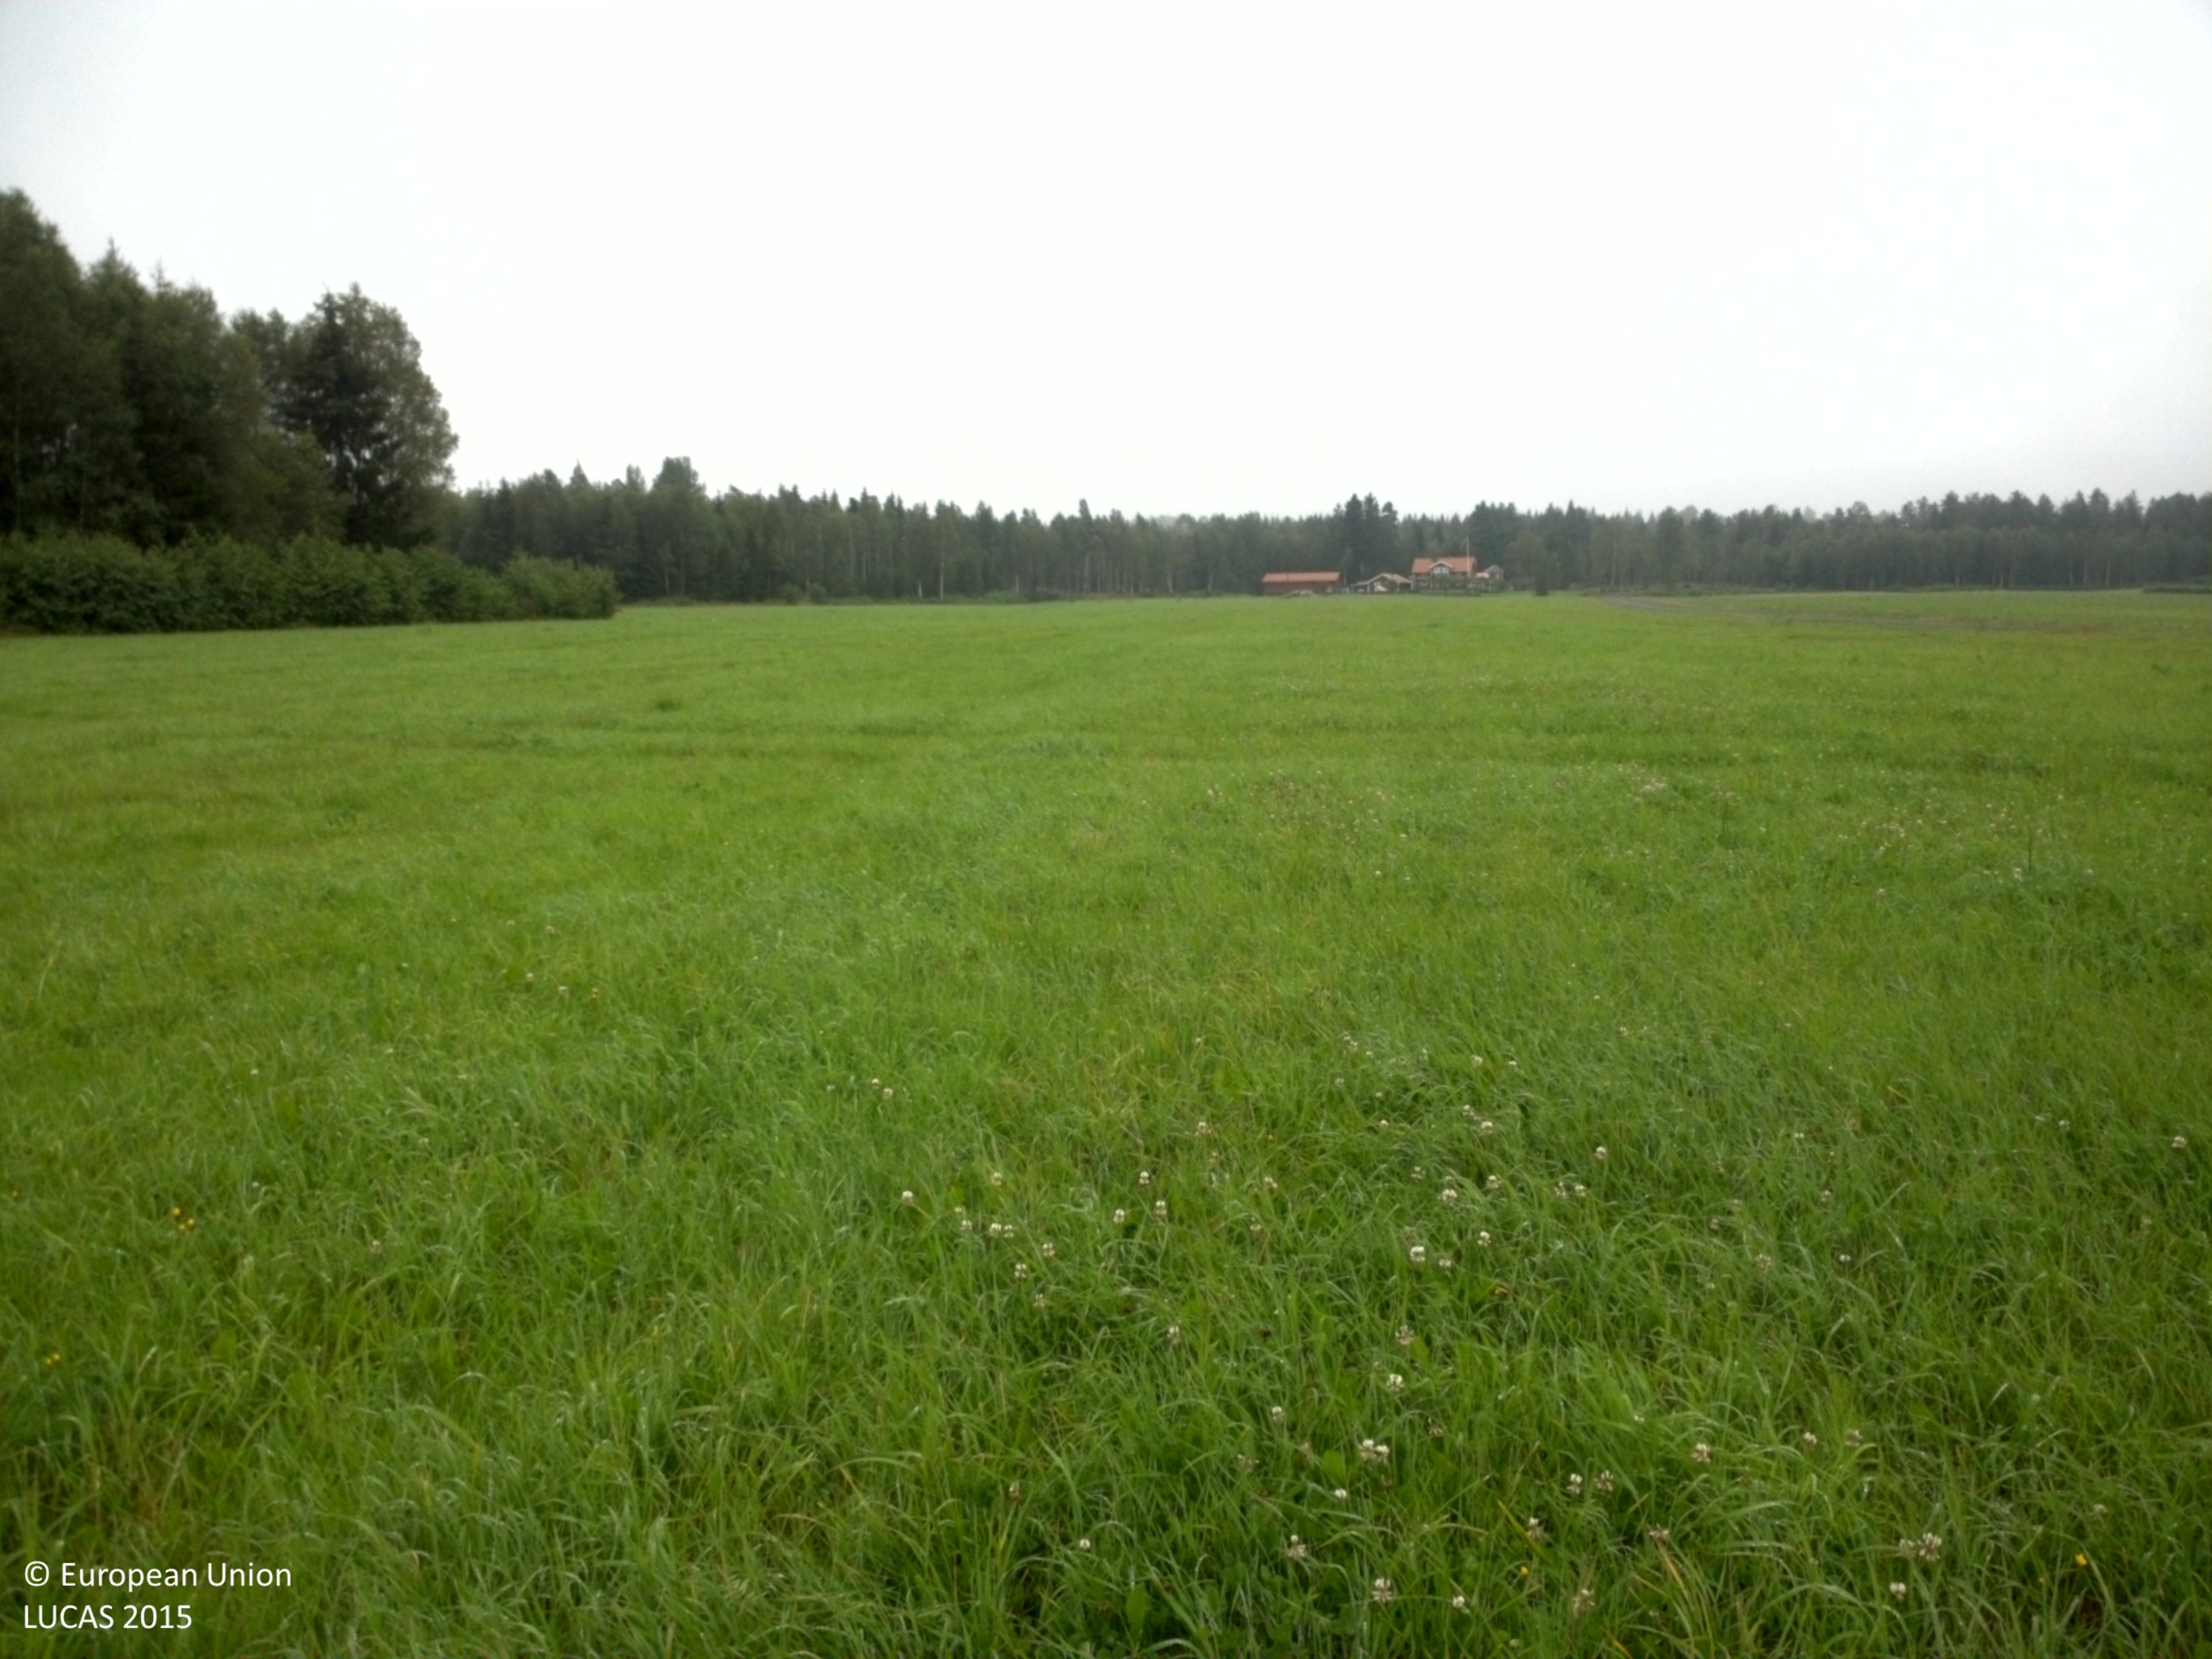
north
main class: Cropland
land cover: Temporary grasslands
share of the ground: 50 - 75 %
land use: Agriculture (excluding fallow land and kitchen gardens)
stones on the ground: < 10 %
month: August
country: SE
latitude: 59.3891
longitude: 13.1442
